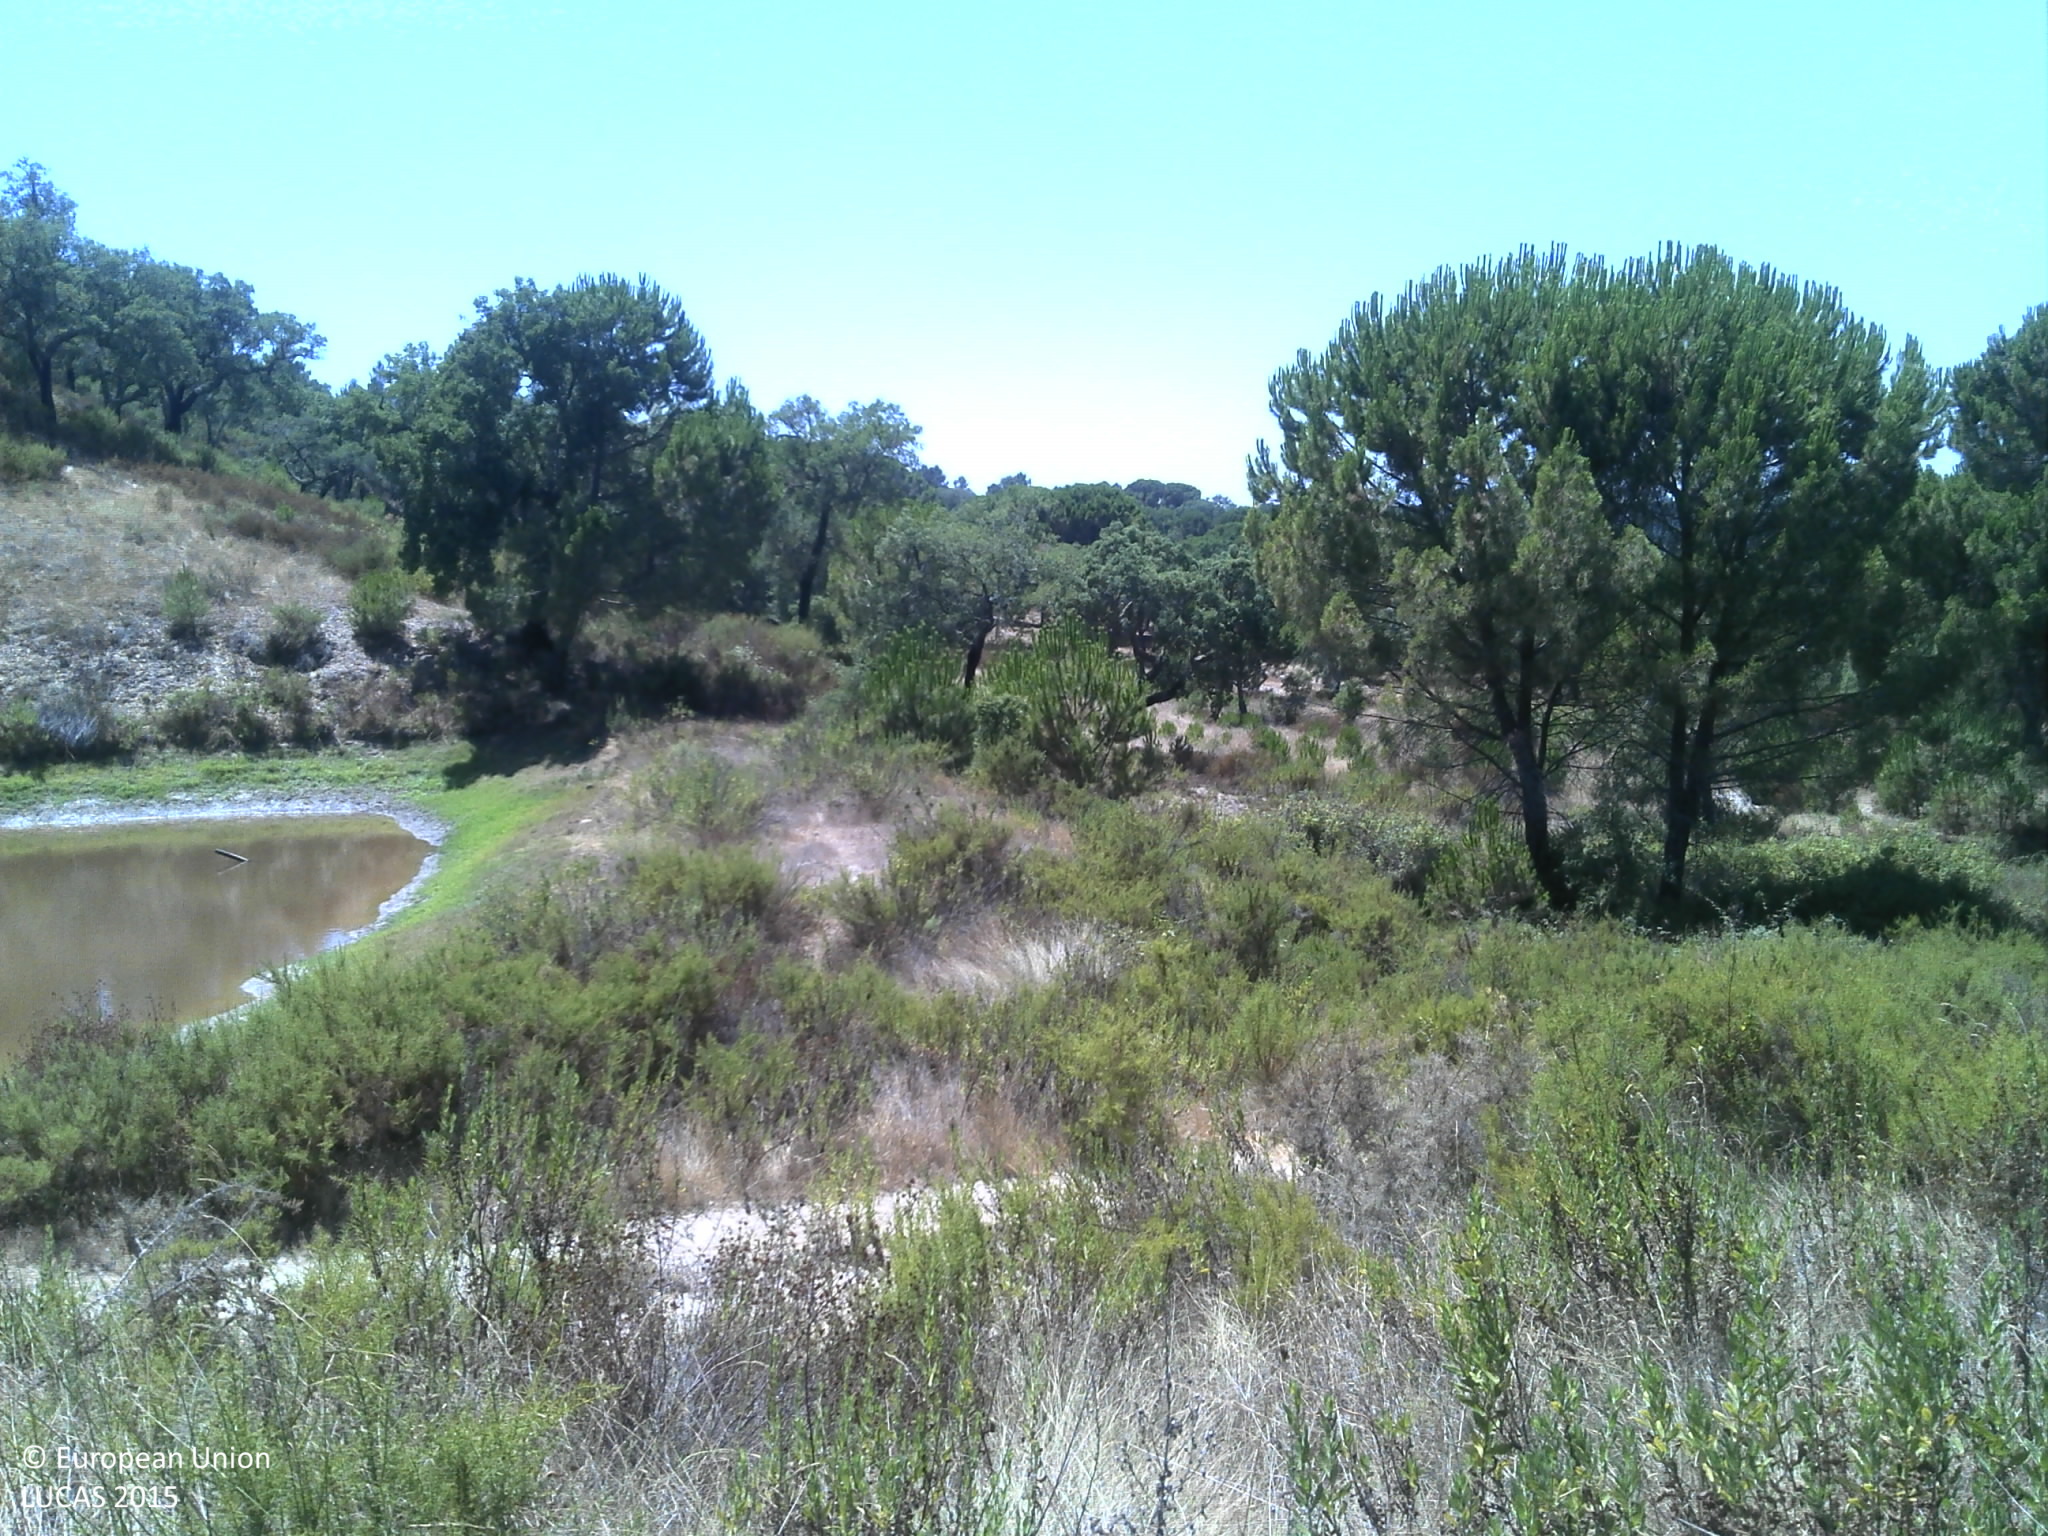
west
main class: Shrubland
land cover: Shrubland without tree cover
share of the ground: 50 - 75 %
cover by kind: shrubs 50 %, unconsolidated bare surface 40 %, herbaceous plants 10 %
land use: Forestry
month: July
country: PT
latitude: 39.0247
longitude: -8.2254
